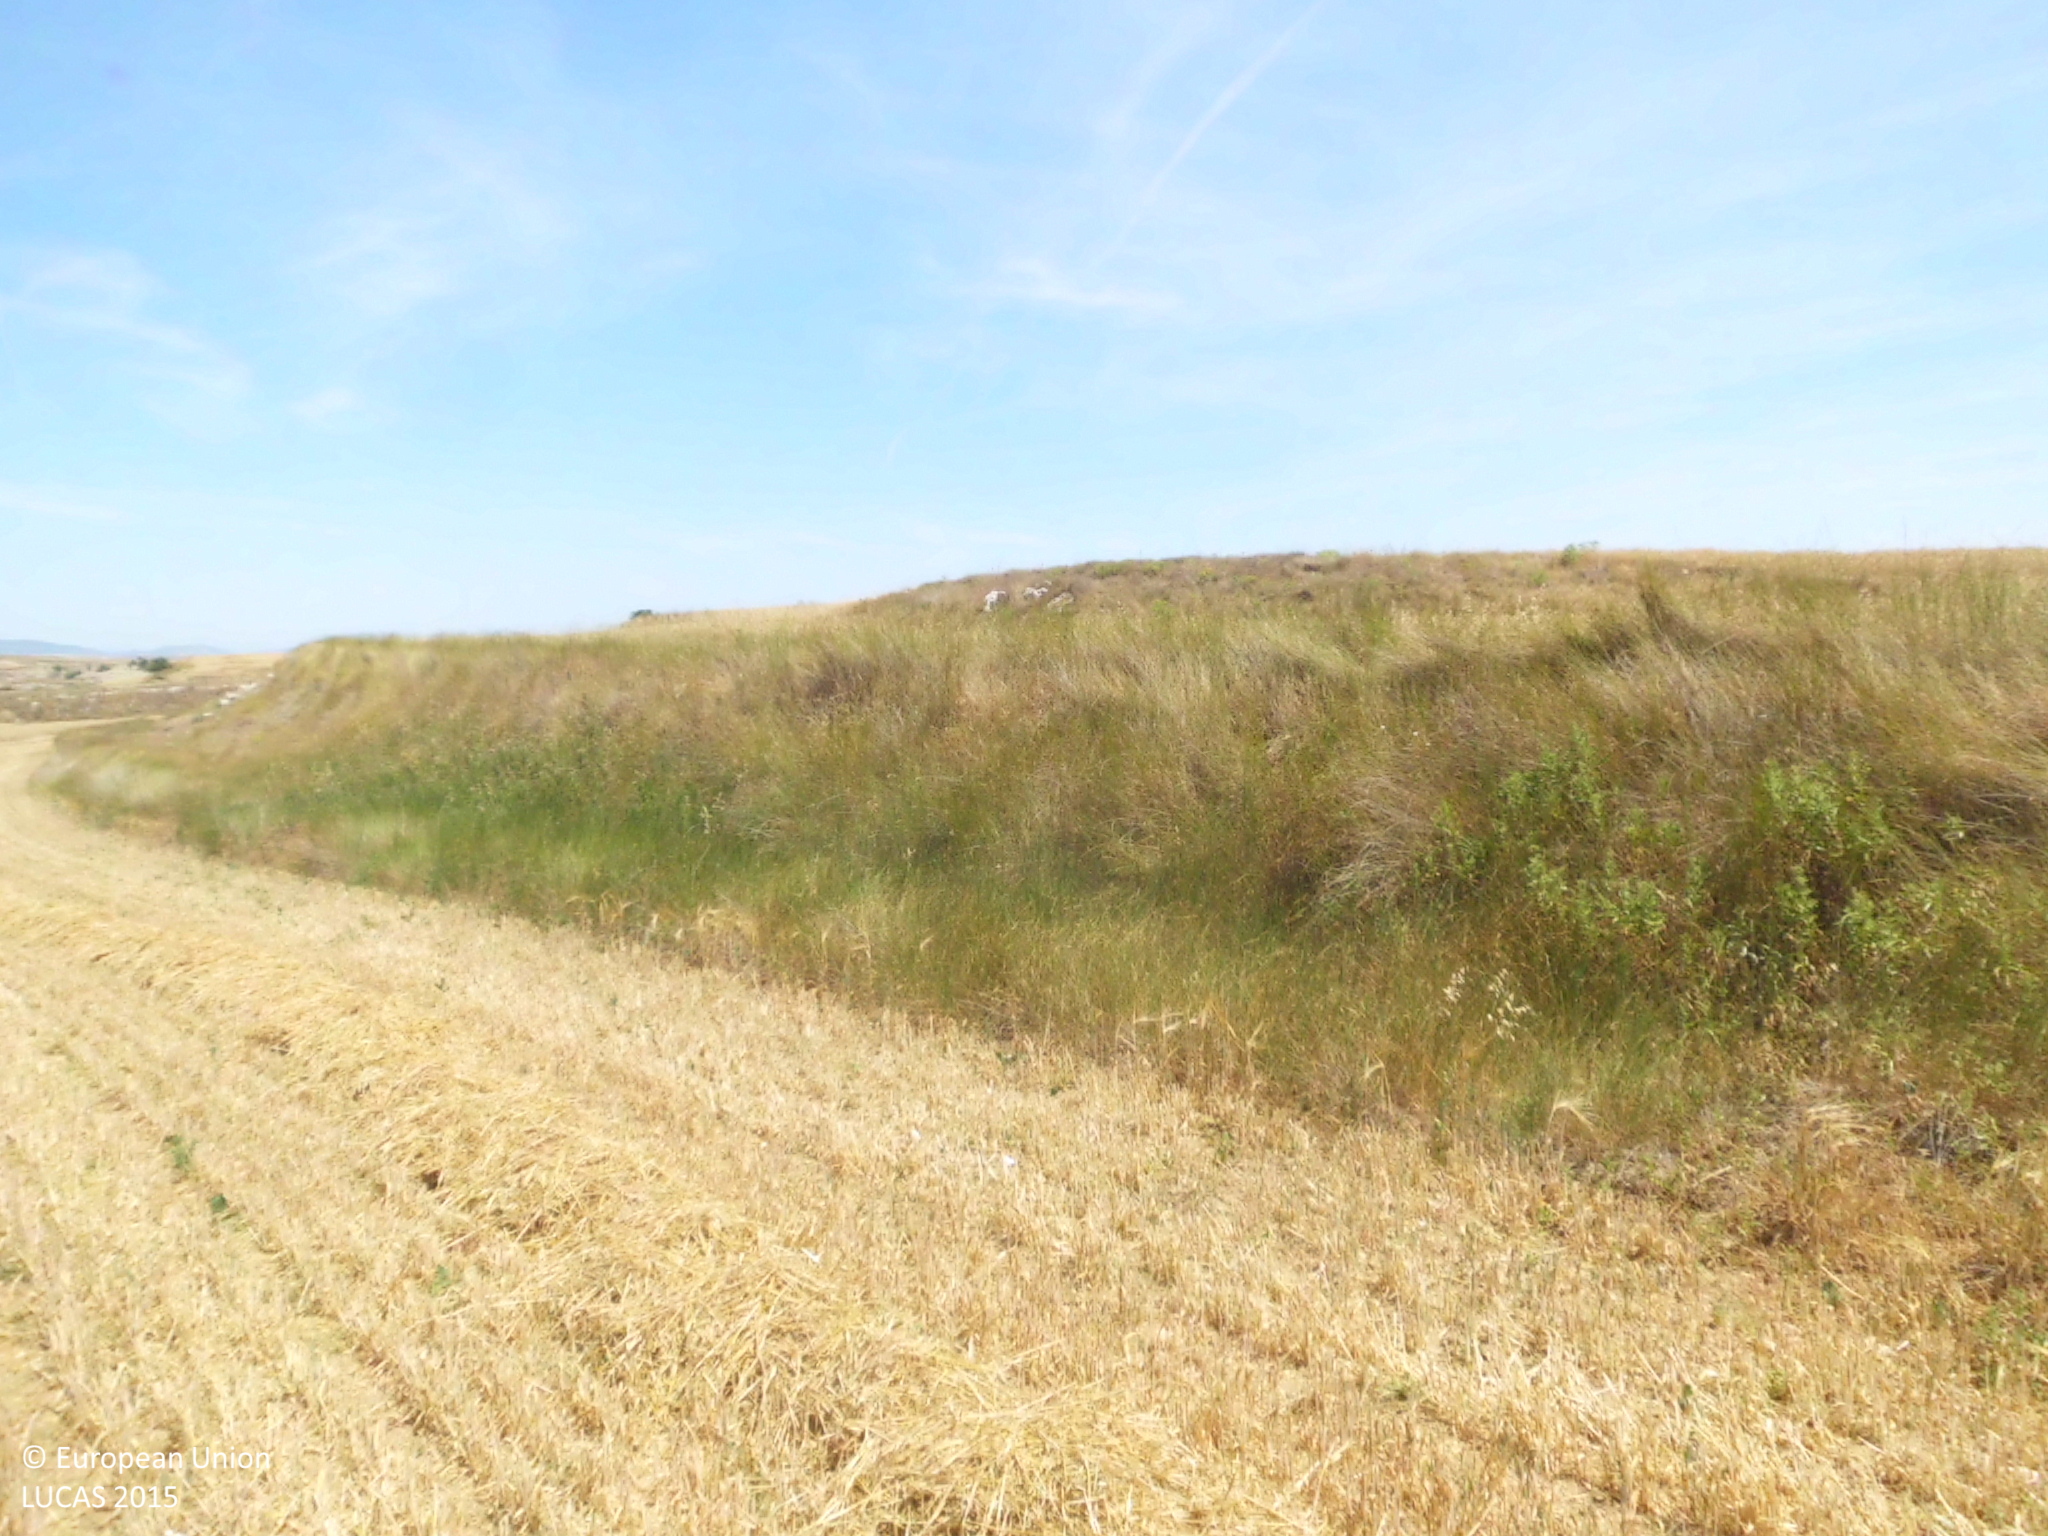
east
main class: Cropland
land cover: Barley
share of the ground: < 10 %
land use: Agriculture (excluding fallow land and kitchen gardens)
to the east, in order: Barley; Grassland without tree/shrub cover; Common wheat; Grassland without tree/shrub cover; Common wheat; Grass margins; Tracks; Common wheat
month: July
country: ES
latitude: 42.4911
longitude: -3.2566
